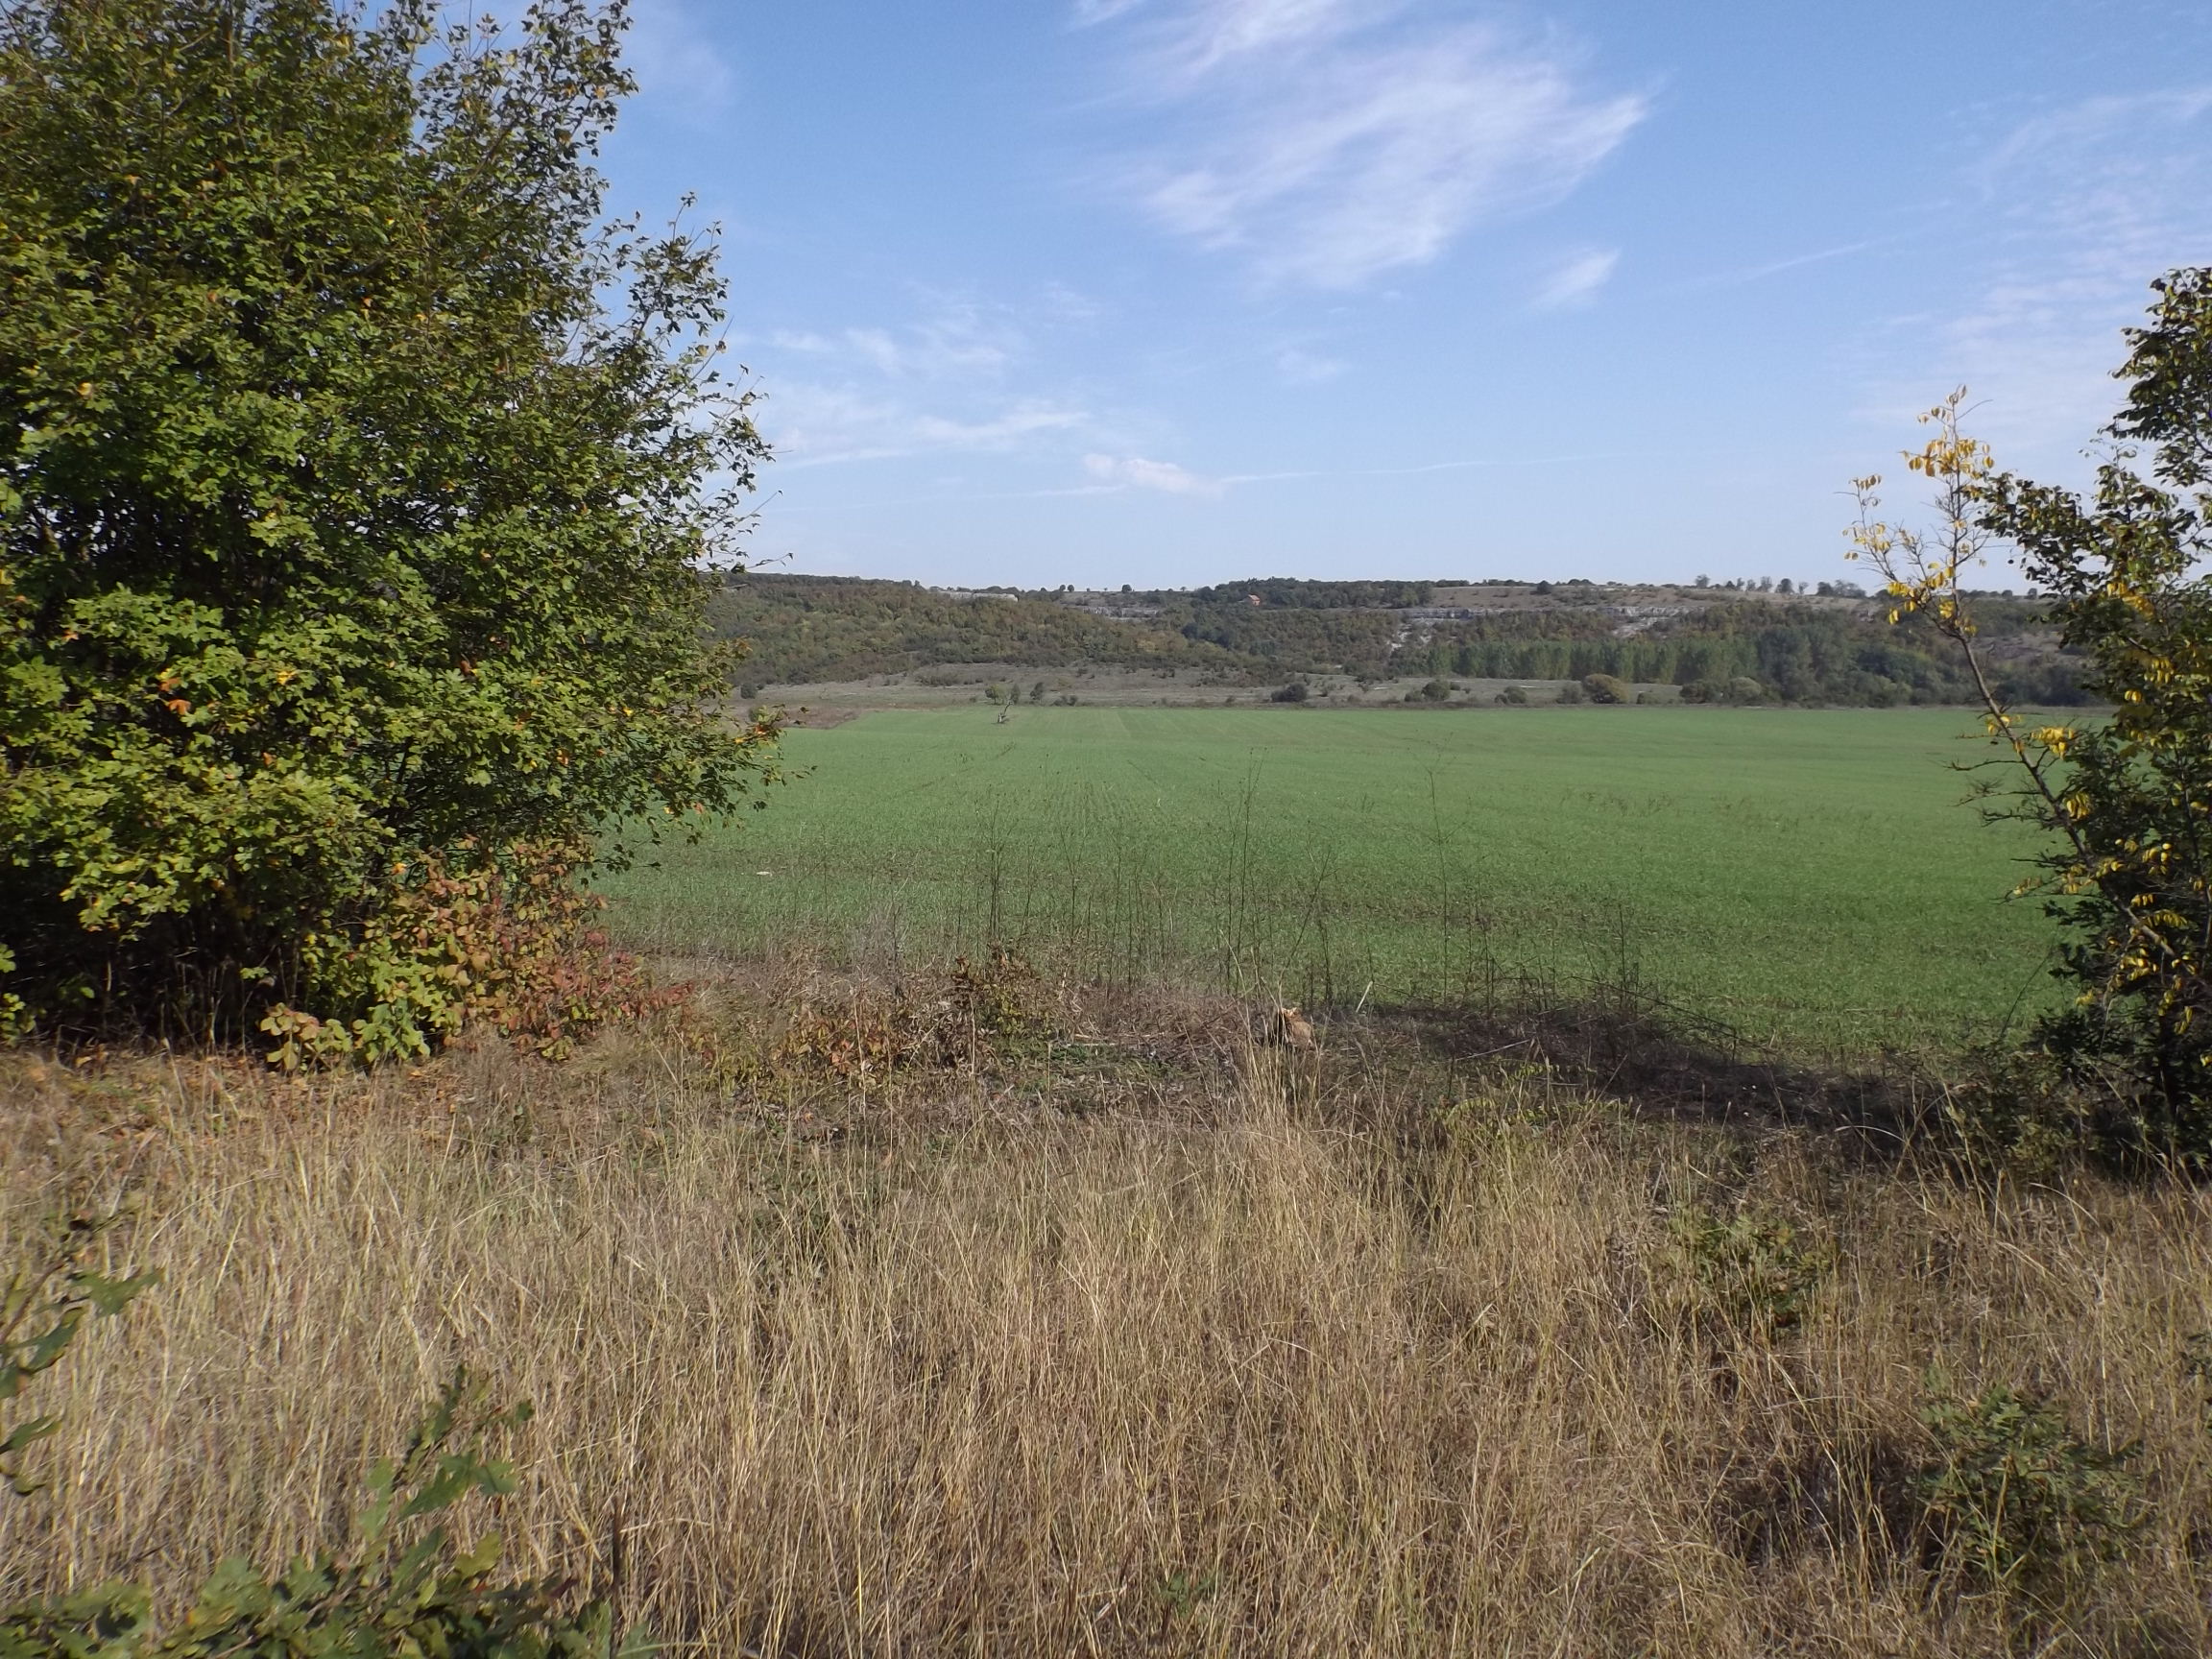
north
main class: Grassland
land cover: Grassland with sparse tree/shrub cover
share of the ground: > 75 %
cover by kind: herbaceous plants 90 %, broadleaved forest trees 5 %, shrubs 5 %
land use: Semi-natural and natural areas not in use
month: October
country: BG
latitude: 43.1546
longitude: 27.2251
